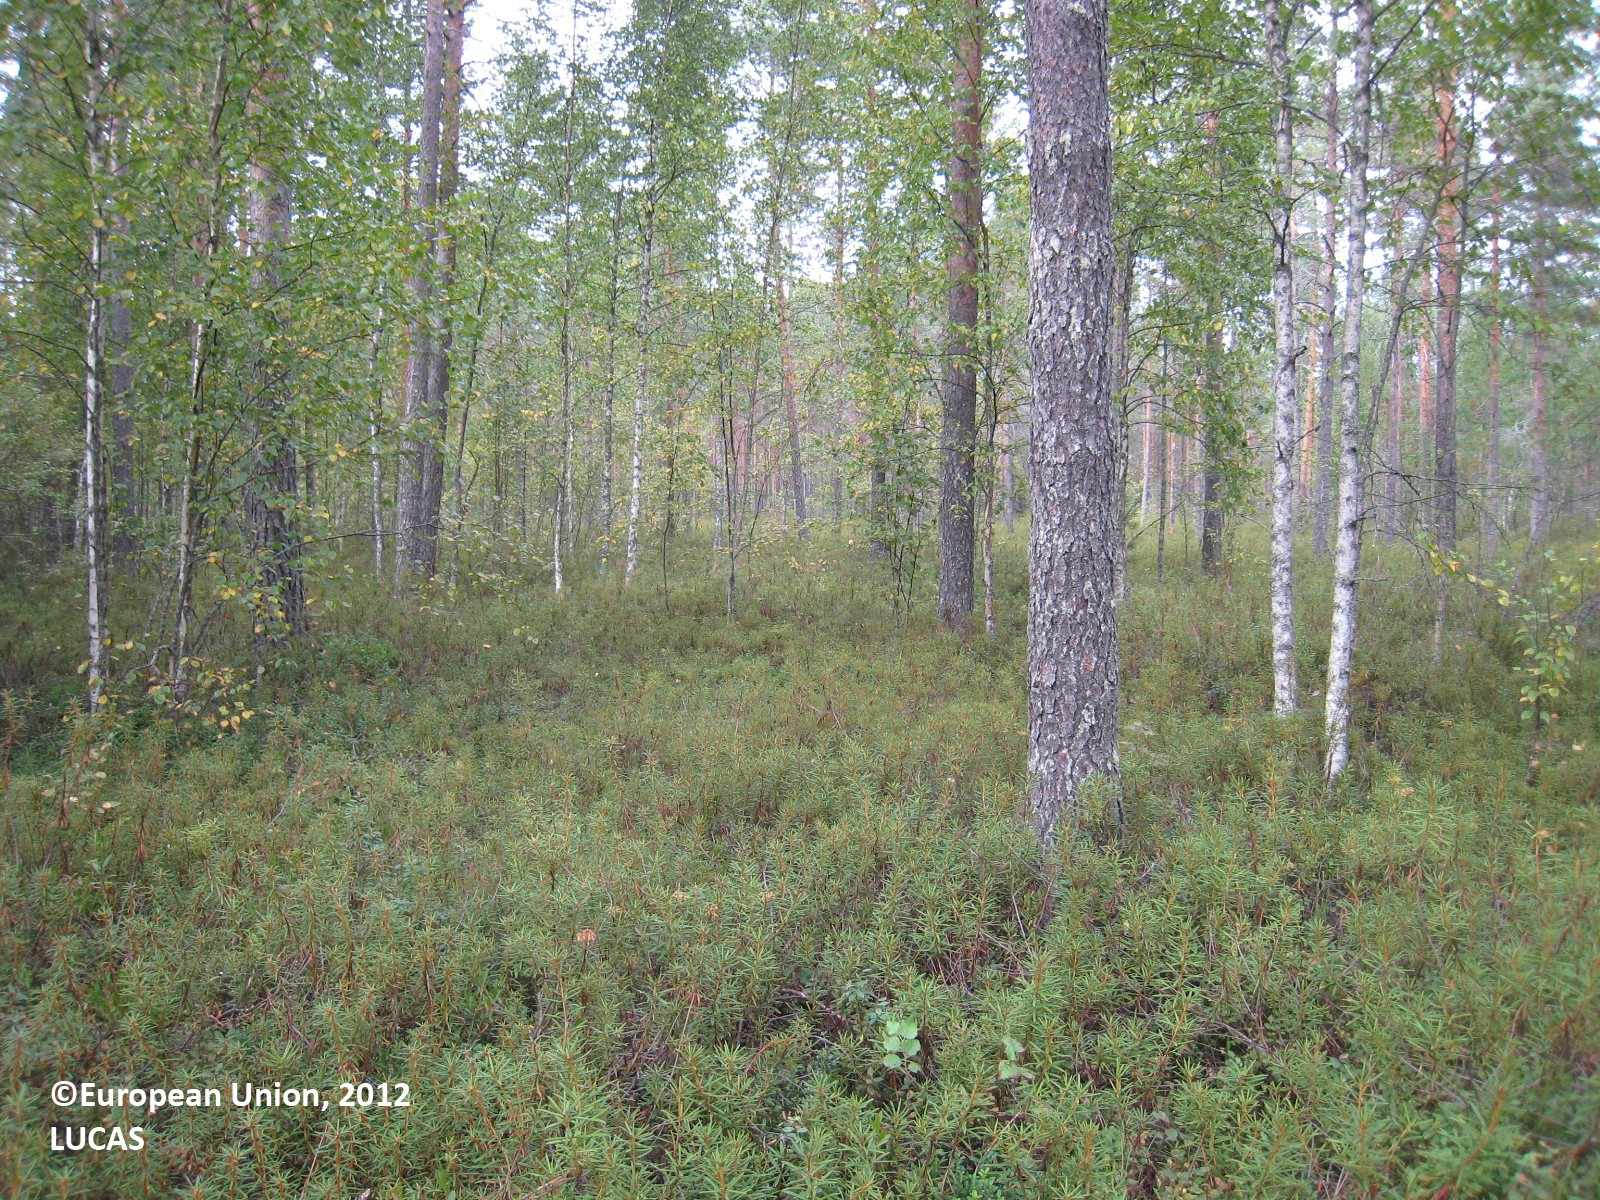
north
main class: Woodland
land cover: Pine dominated mixed woodland
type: mire and swamp forests
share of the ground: 50 - 75 %
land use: Forestry
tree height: > 5 m
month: August
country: FI
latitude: 62.2068
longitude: 27.1736
